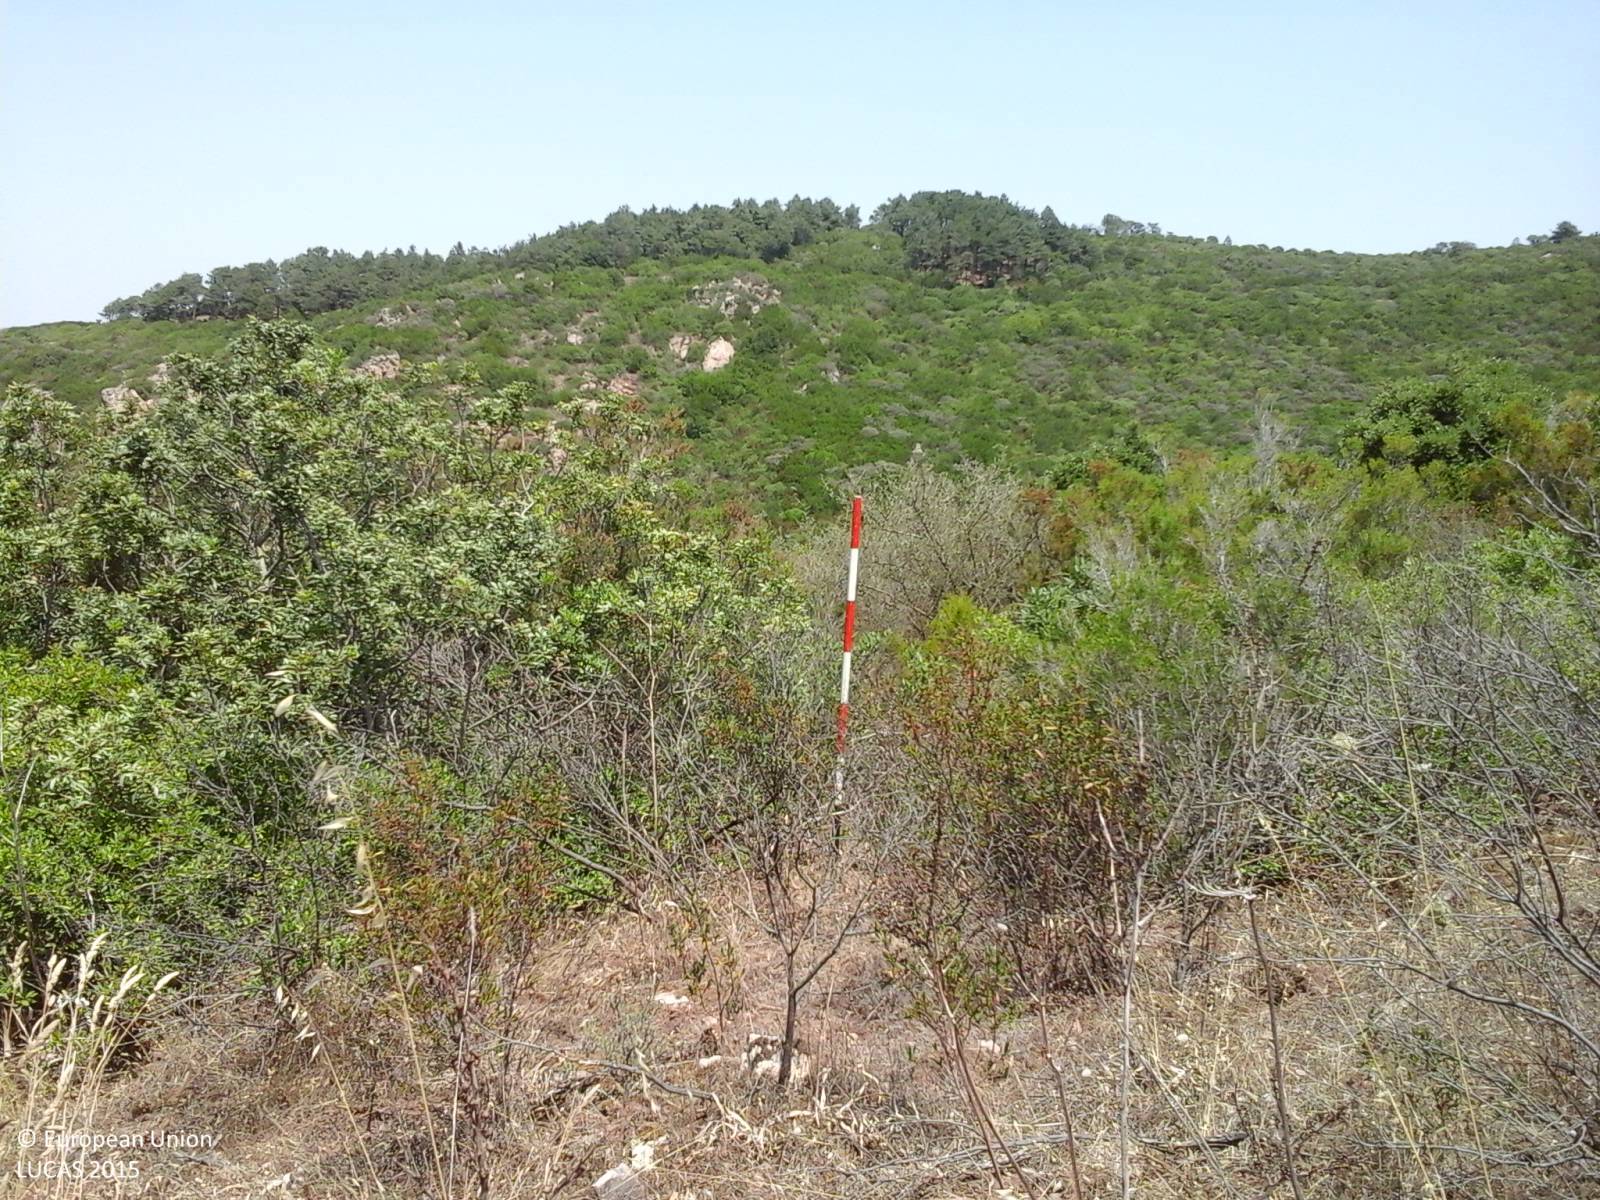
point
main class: Shrubland
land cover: Shrubland with sparse tree cover
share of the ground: > 75 %
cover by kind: shrubs 95 %, broadleaved forest trees 5 %
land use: Semi-natural and natural areas not in use
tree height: < 5 m
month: July
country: IT
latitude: 39.9522
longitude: 8.8010
